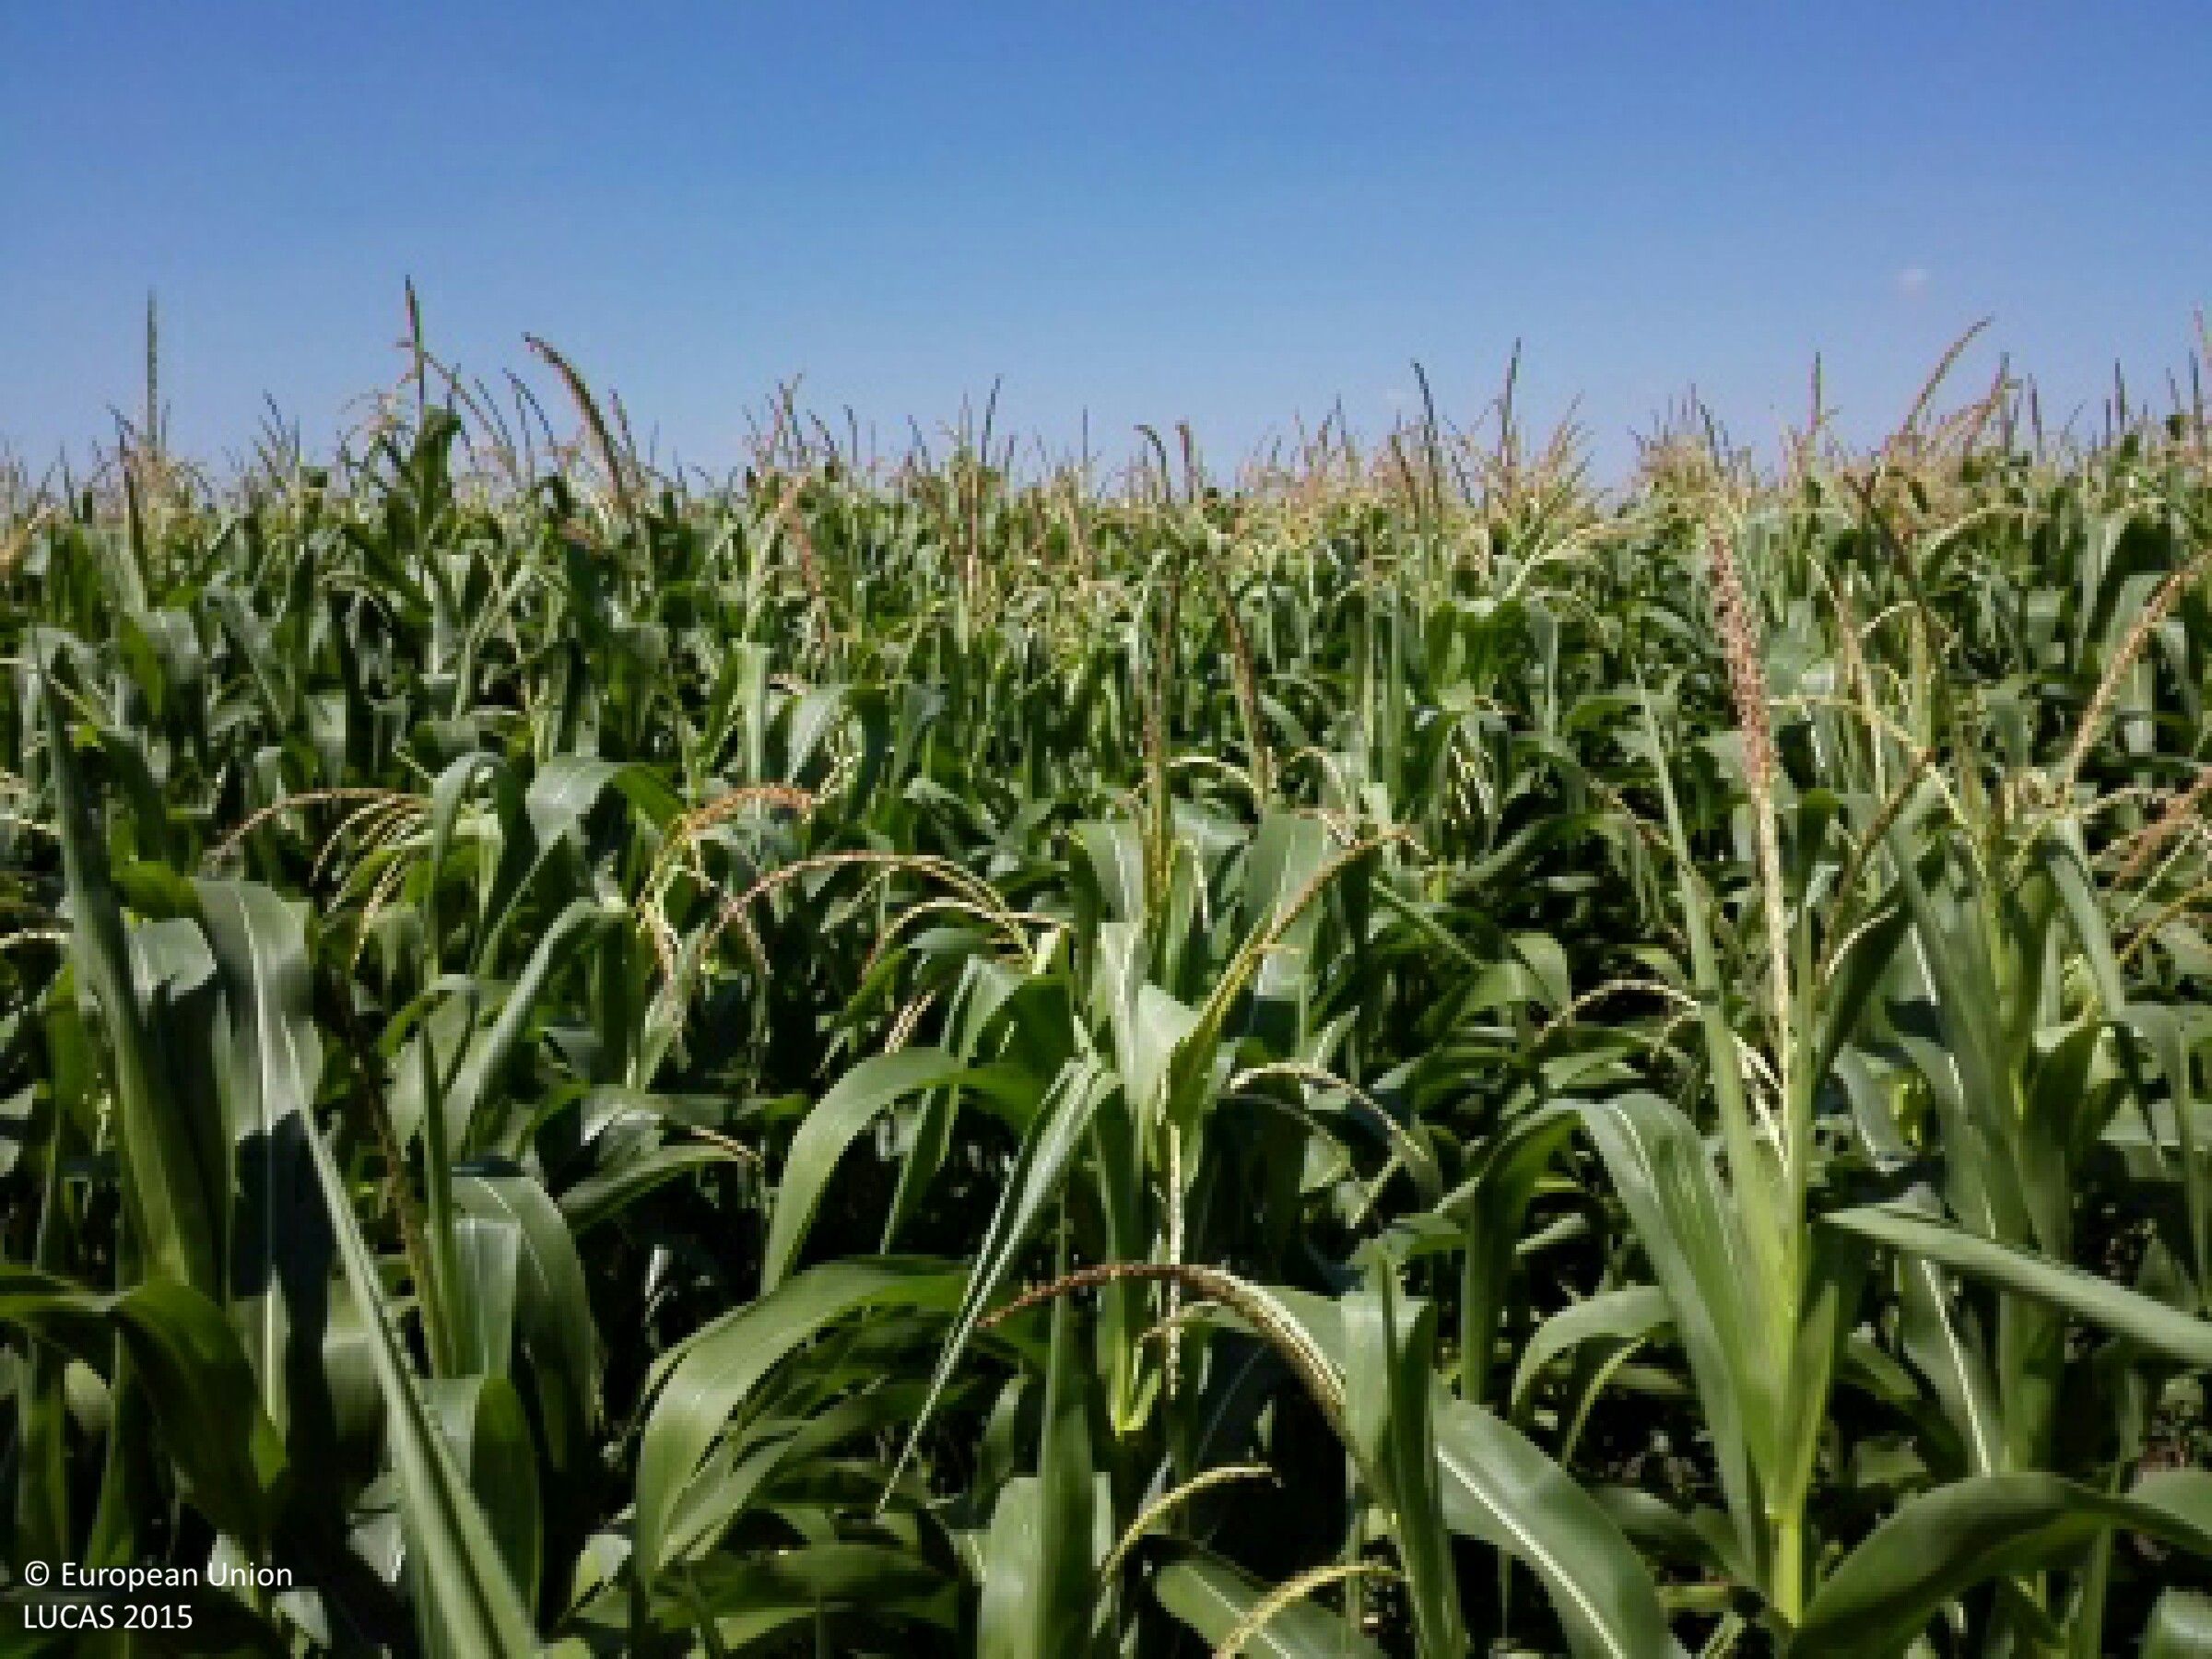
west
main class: Cropland
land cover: Maize
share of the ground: > 75 %
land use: Agriculture (excluding fallow land and kitchen gardens)
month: July
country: HU
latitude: 47.7755
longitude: 21.3994
